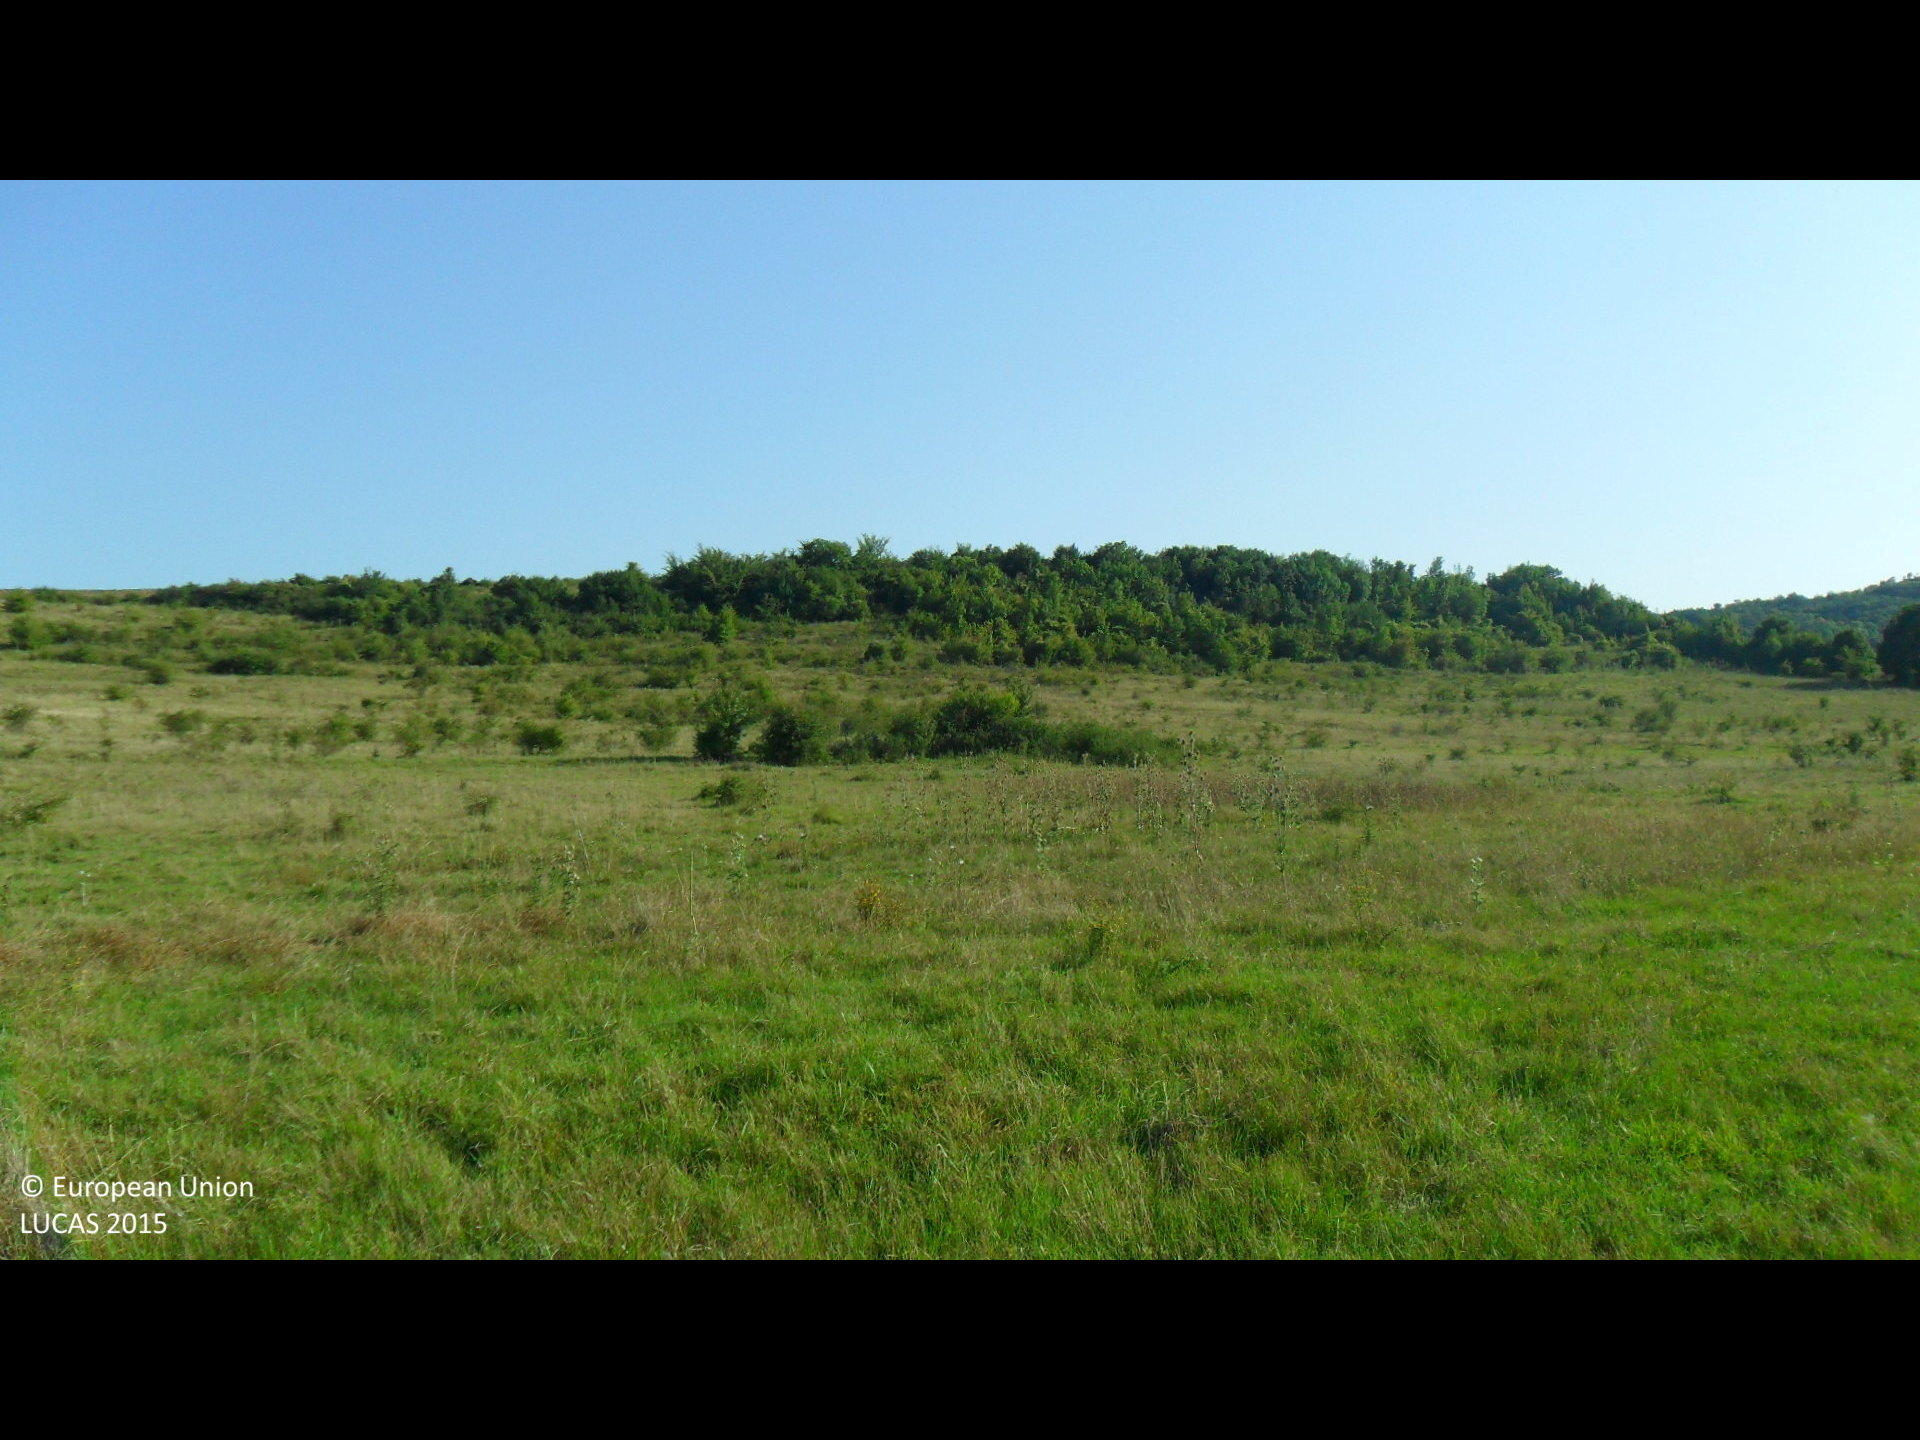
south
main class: Grassland
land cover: Grassland without tree/shrub cover
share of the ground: > 75 %
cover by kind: herbaceous plants 100 %
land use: Agriculture (excluding fallow land and kitchen gardens)
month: August
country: BG
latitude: 43.3185
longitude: 26.4643
